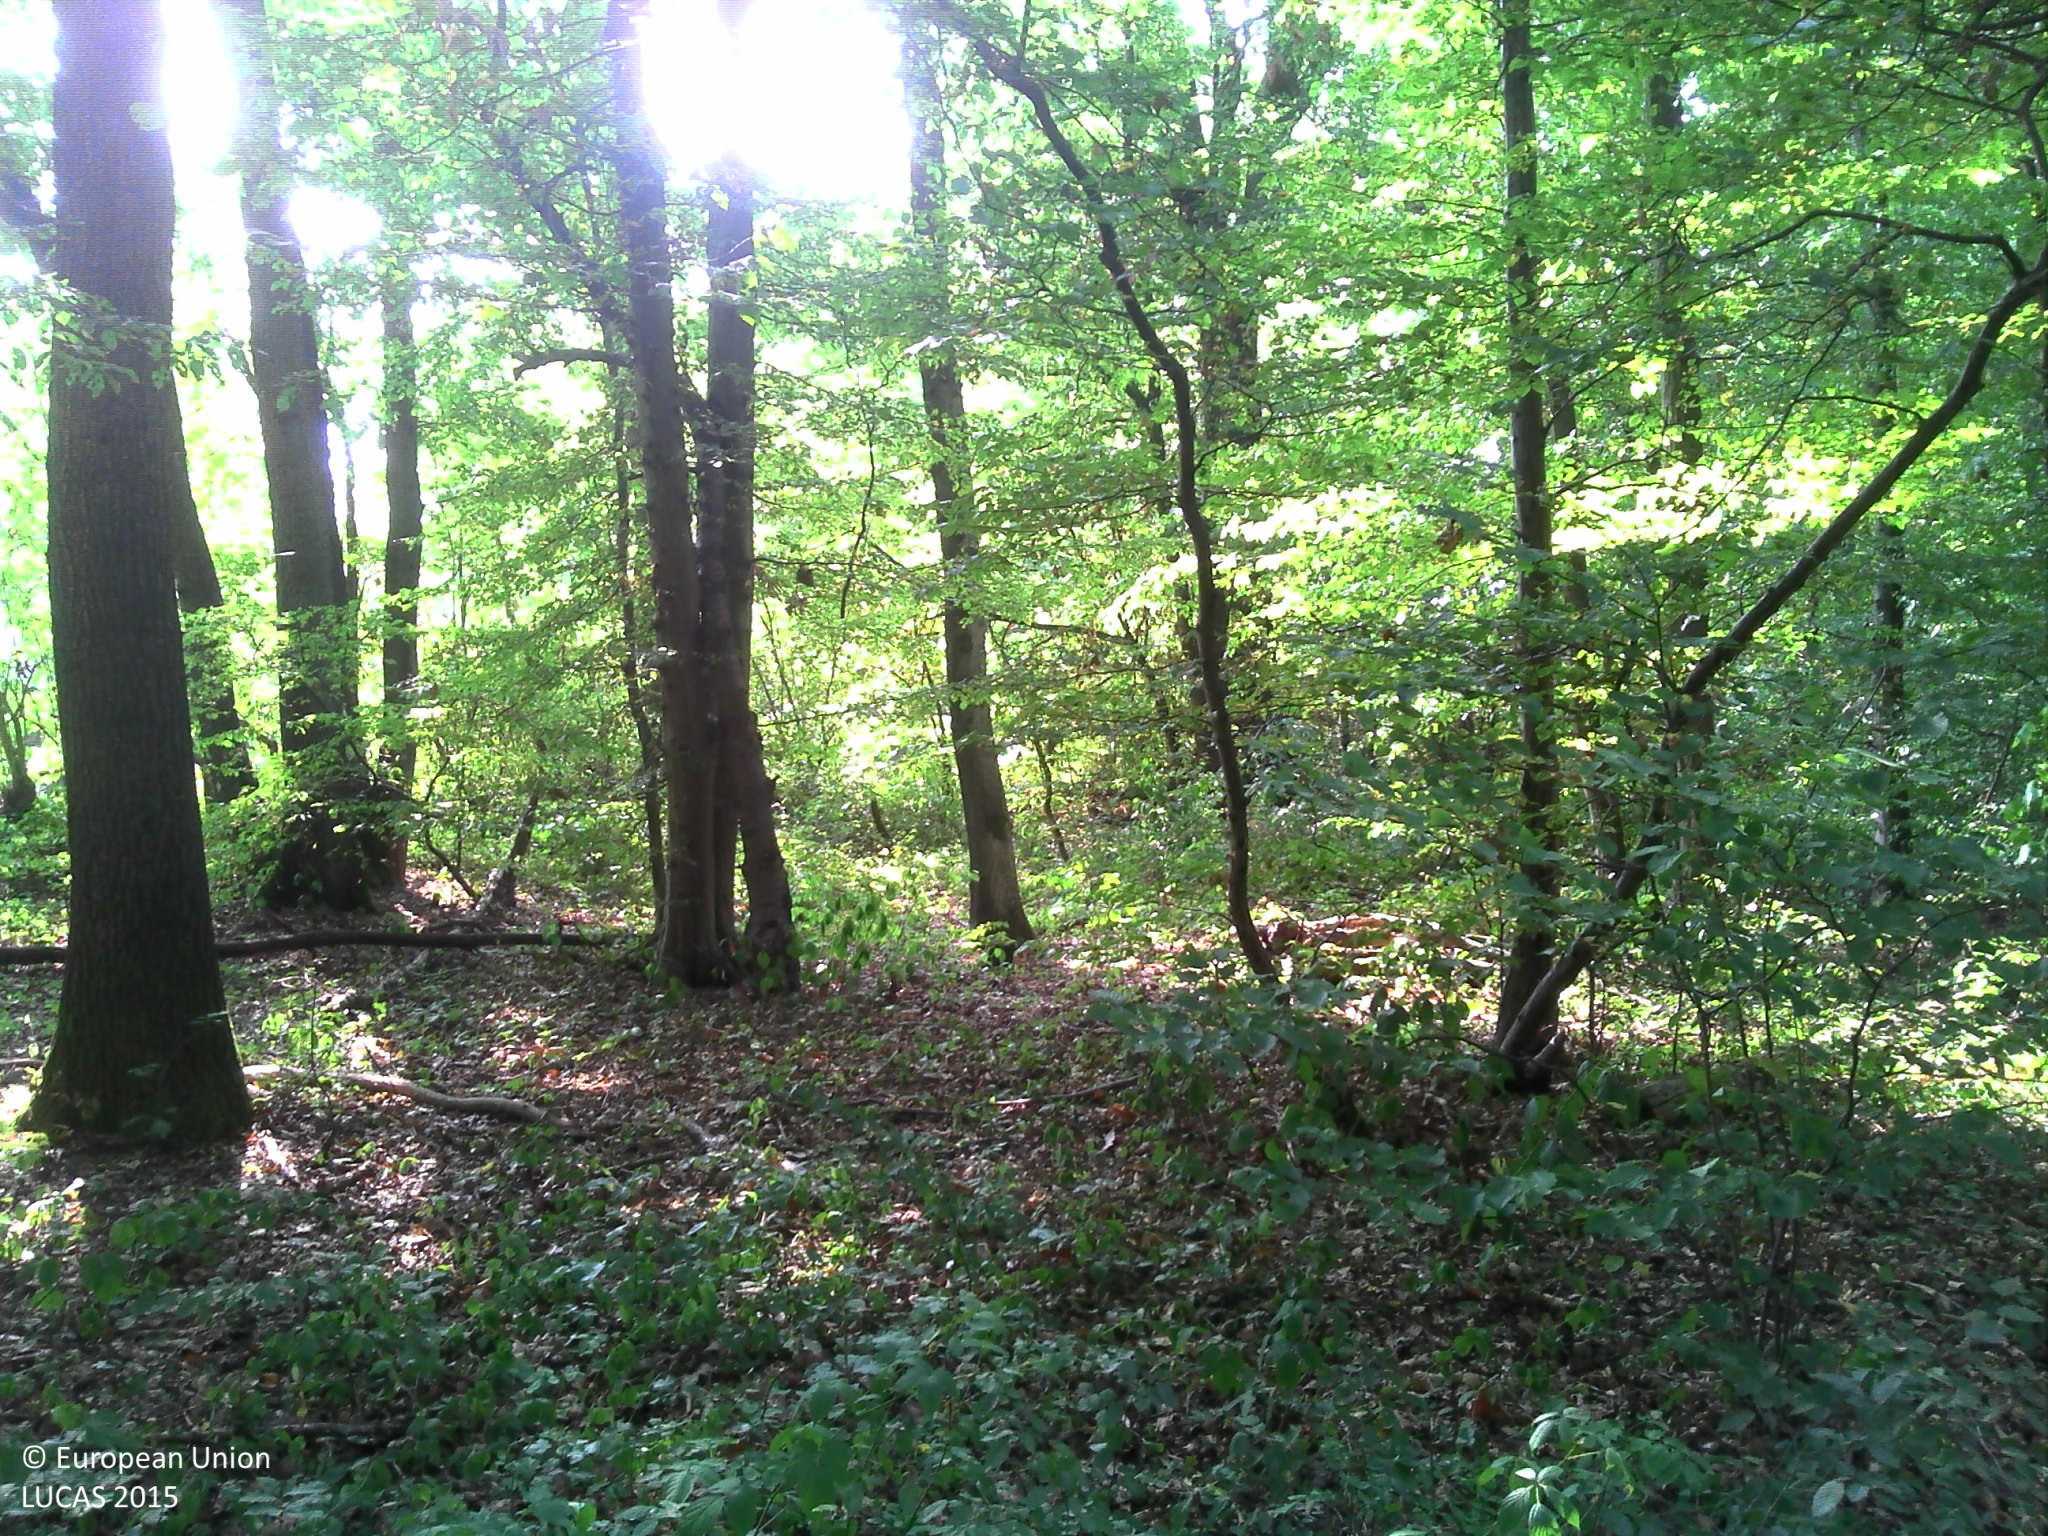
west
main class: Woodland
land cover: Broadleaved woodland
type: acidophilous oak and oak-birch forest
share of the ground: > 75 %
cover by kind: broadleaved forest trees 60 %, herbaceous plants 15 %, lichens and mosses 15 %, unconsolidated bare surface 10 %
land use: Forestry
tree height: > 5 m
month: August
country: FR
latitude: 48.9182
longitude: 2.6614
